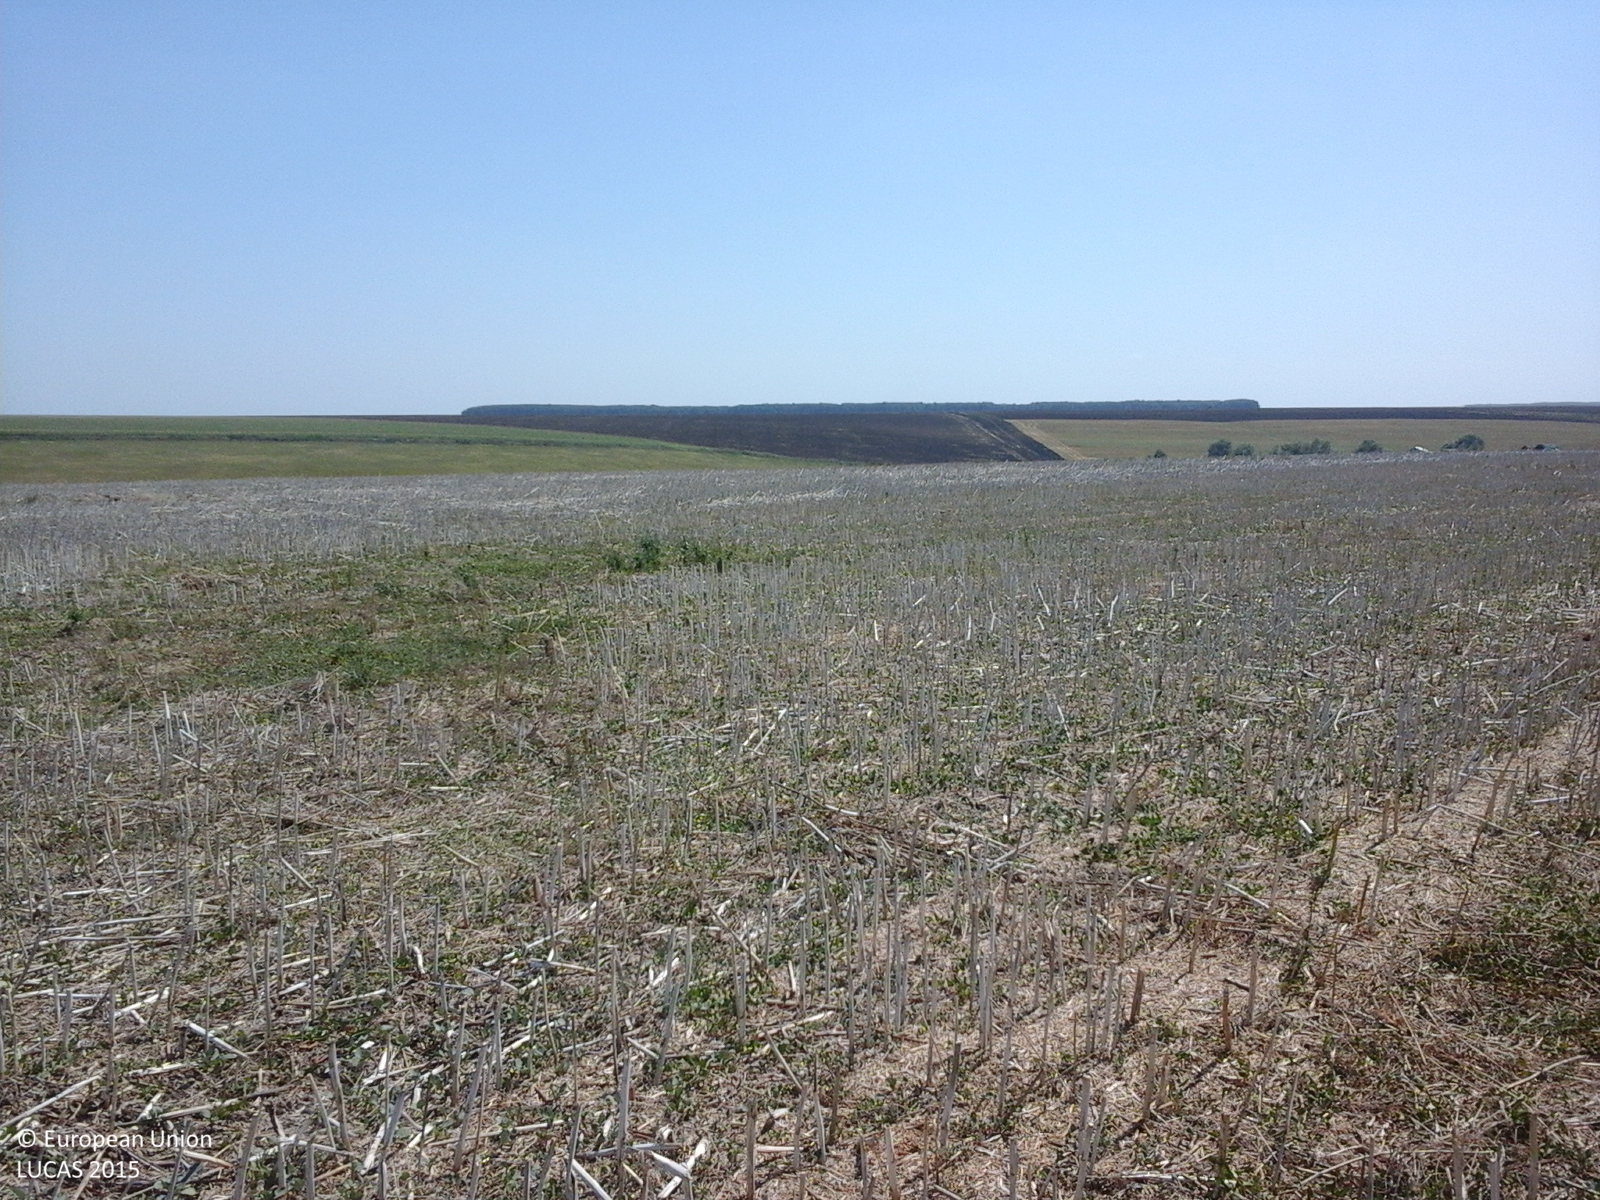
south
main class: Cropland
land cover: Rape and turnip rape
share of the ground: 25 - 50 %
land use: Agriculture (excluding fallow land and kitchen gardens)
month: July
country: RO
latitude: 44.3774
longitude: 26.6217
